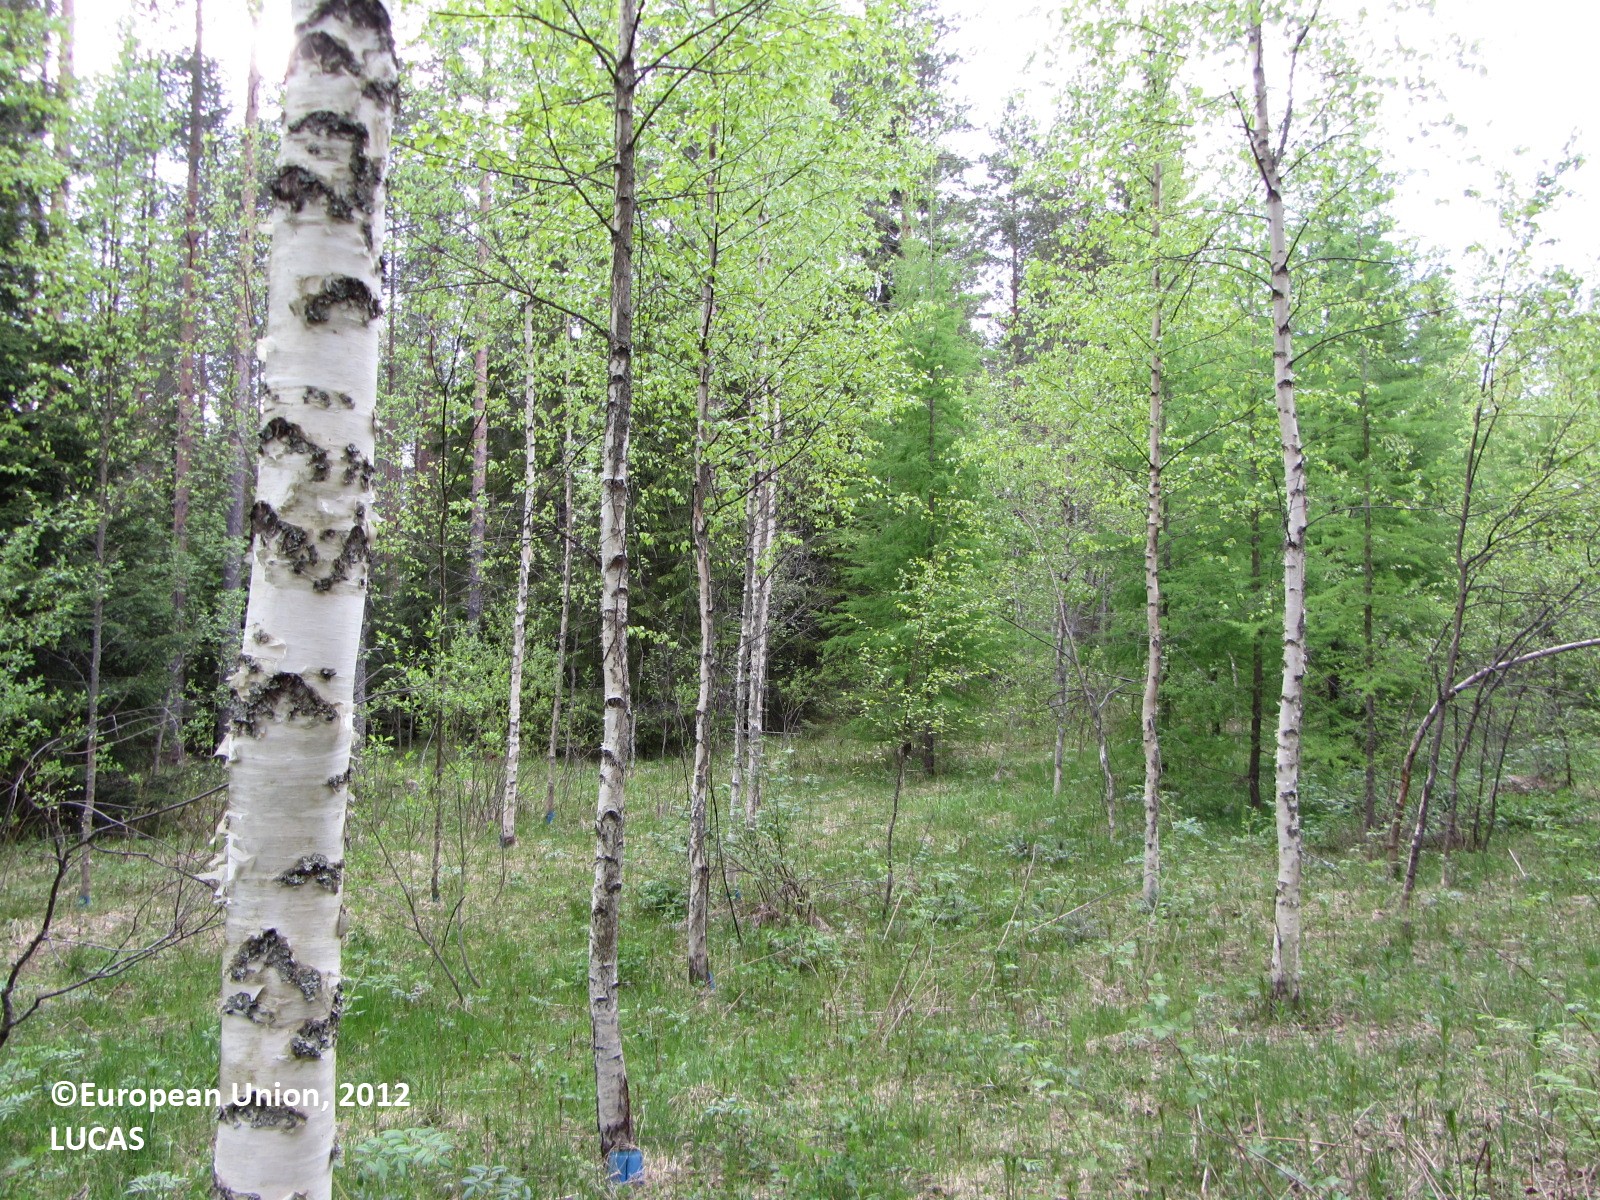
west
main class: Woodland
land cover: Broadleaved woodland
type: boreal forest
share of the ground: > 75 %
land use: Forestry
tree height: > 5 m
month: May
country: FI
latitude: 62.4014
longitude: 25.4156
